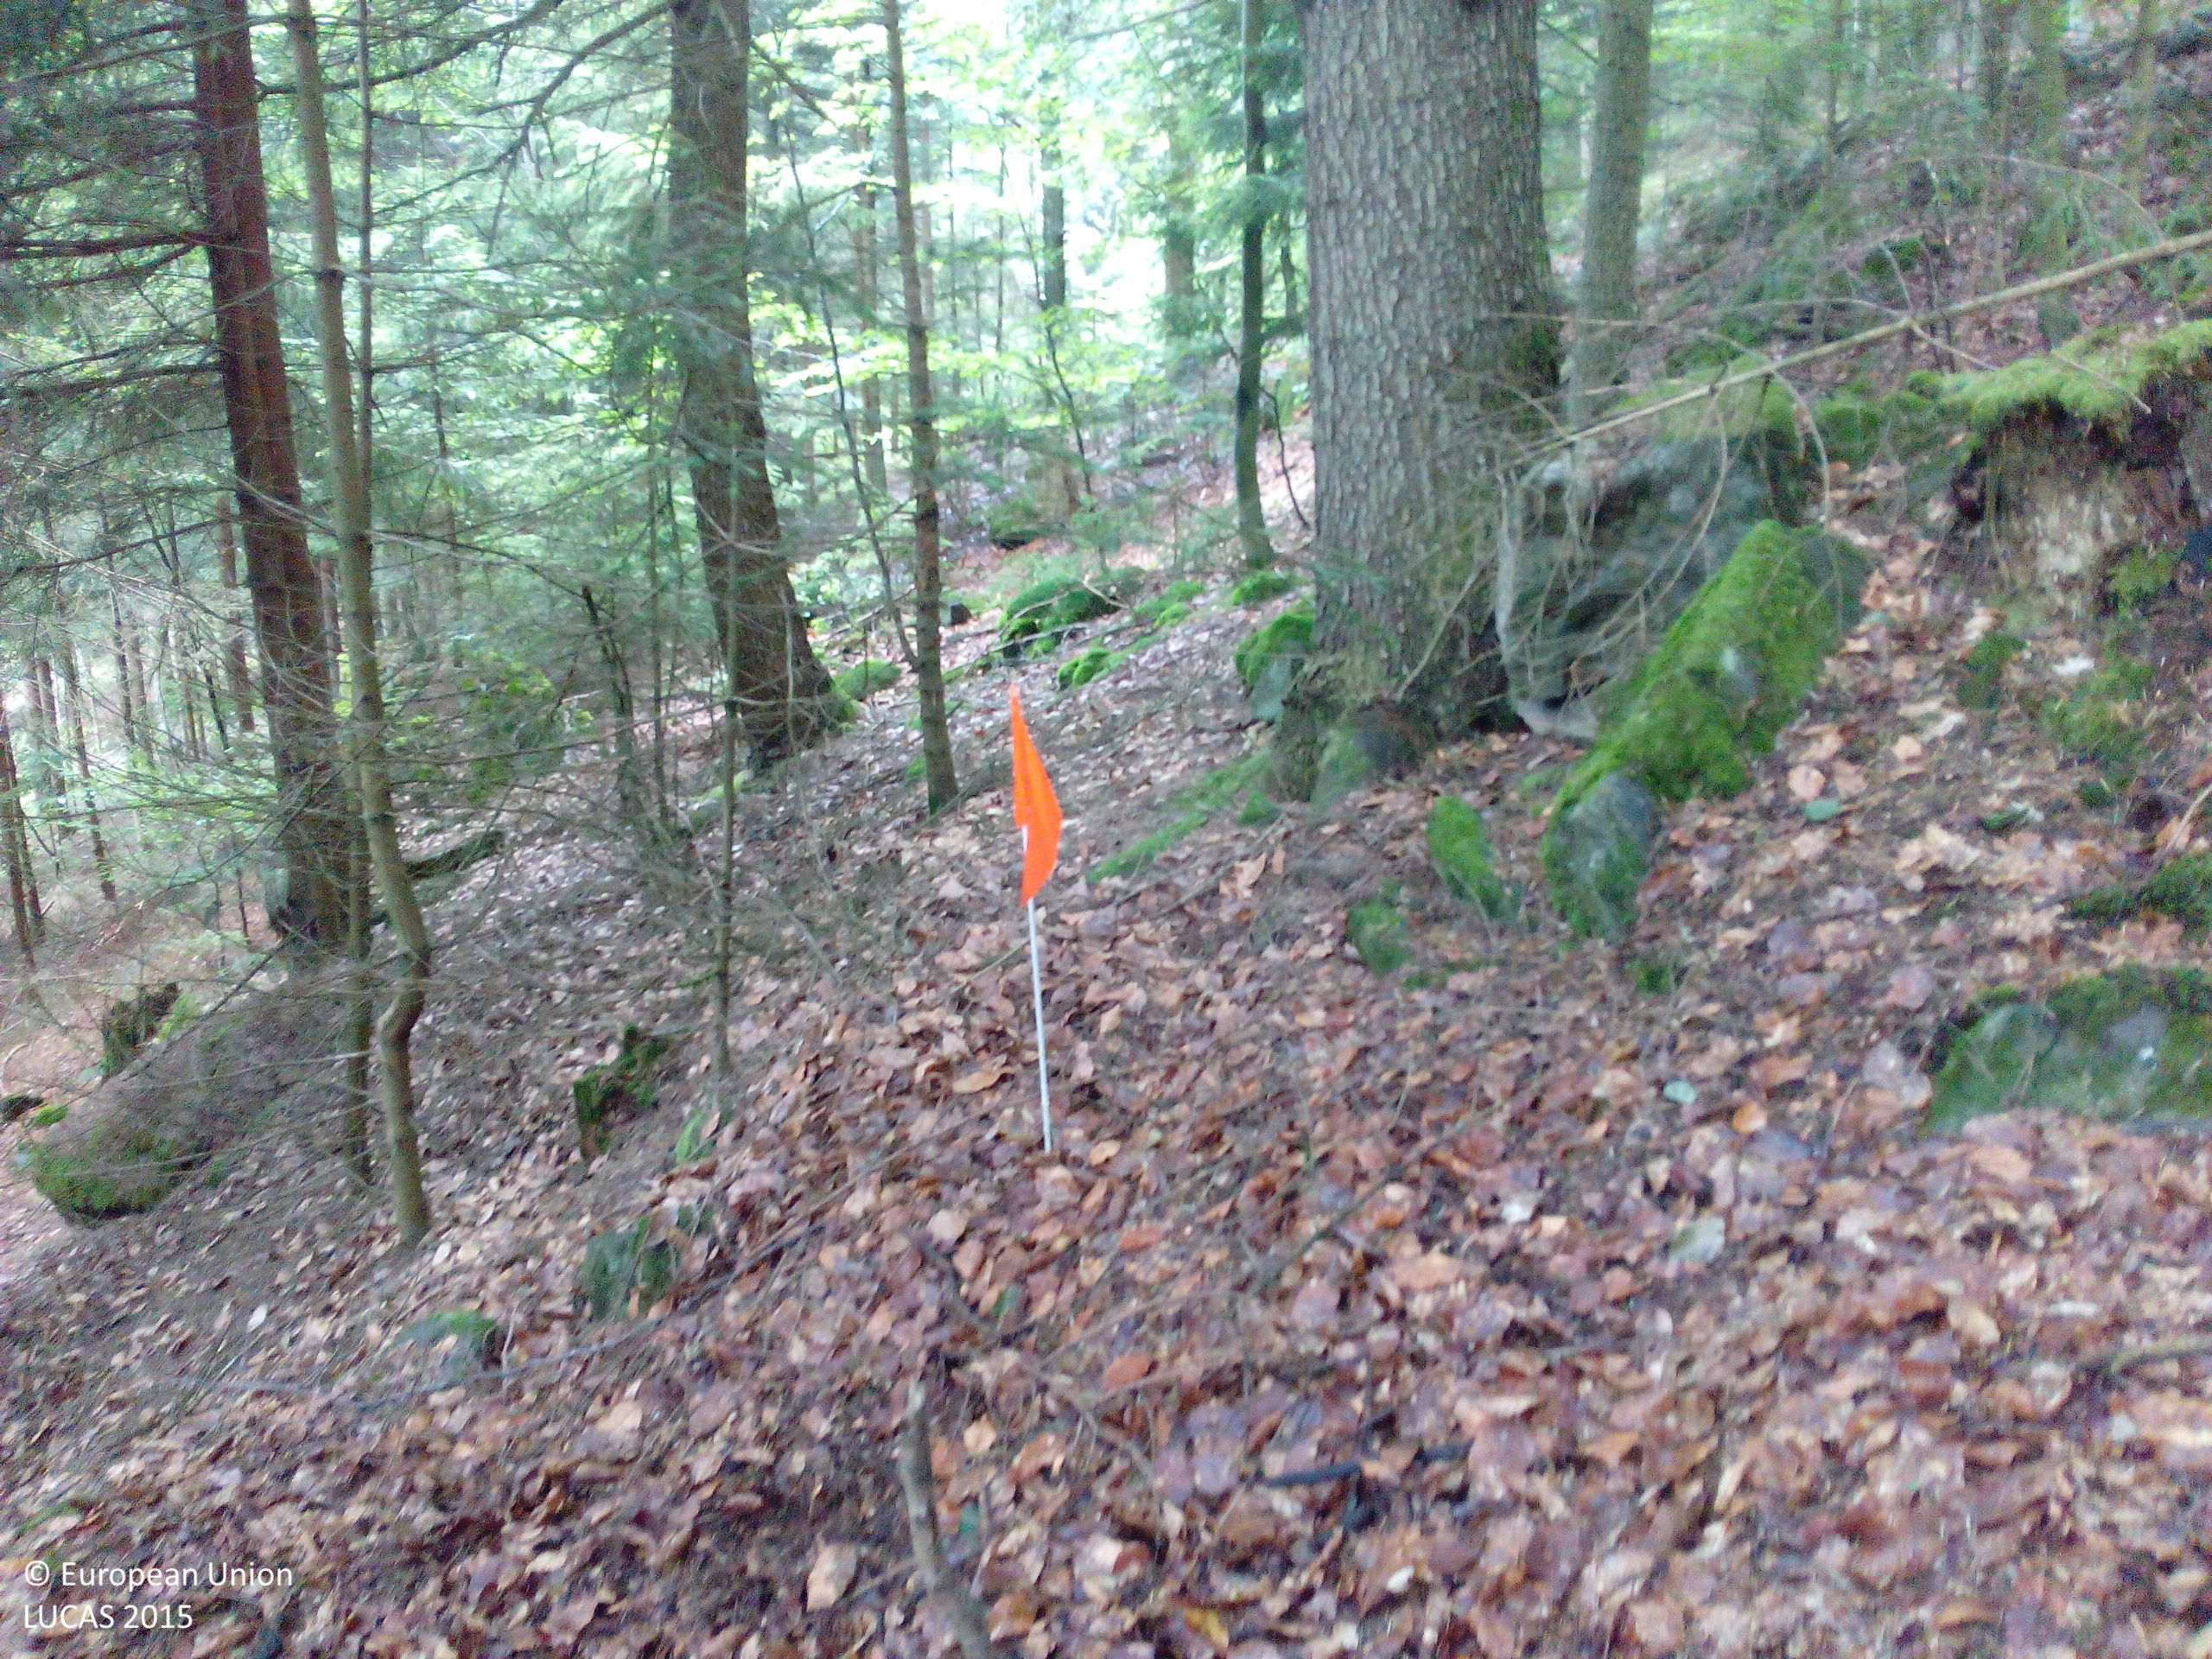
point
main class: Woodland
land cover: Spruce dominated mixed woodland
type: hemiboreal forest and nemoral coniferous forest and mixed broadleaved-coniferous forest
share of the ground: > 75 %
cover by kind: coniferous forest trees 60 %, broadleaved forest trees 25 %, unconsolidated bare surface 10 %, lichens and mosses 5 %
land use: Forestry
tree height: > 5 m
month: July
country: DE
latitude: 49.1556
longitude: 12.9751
